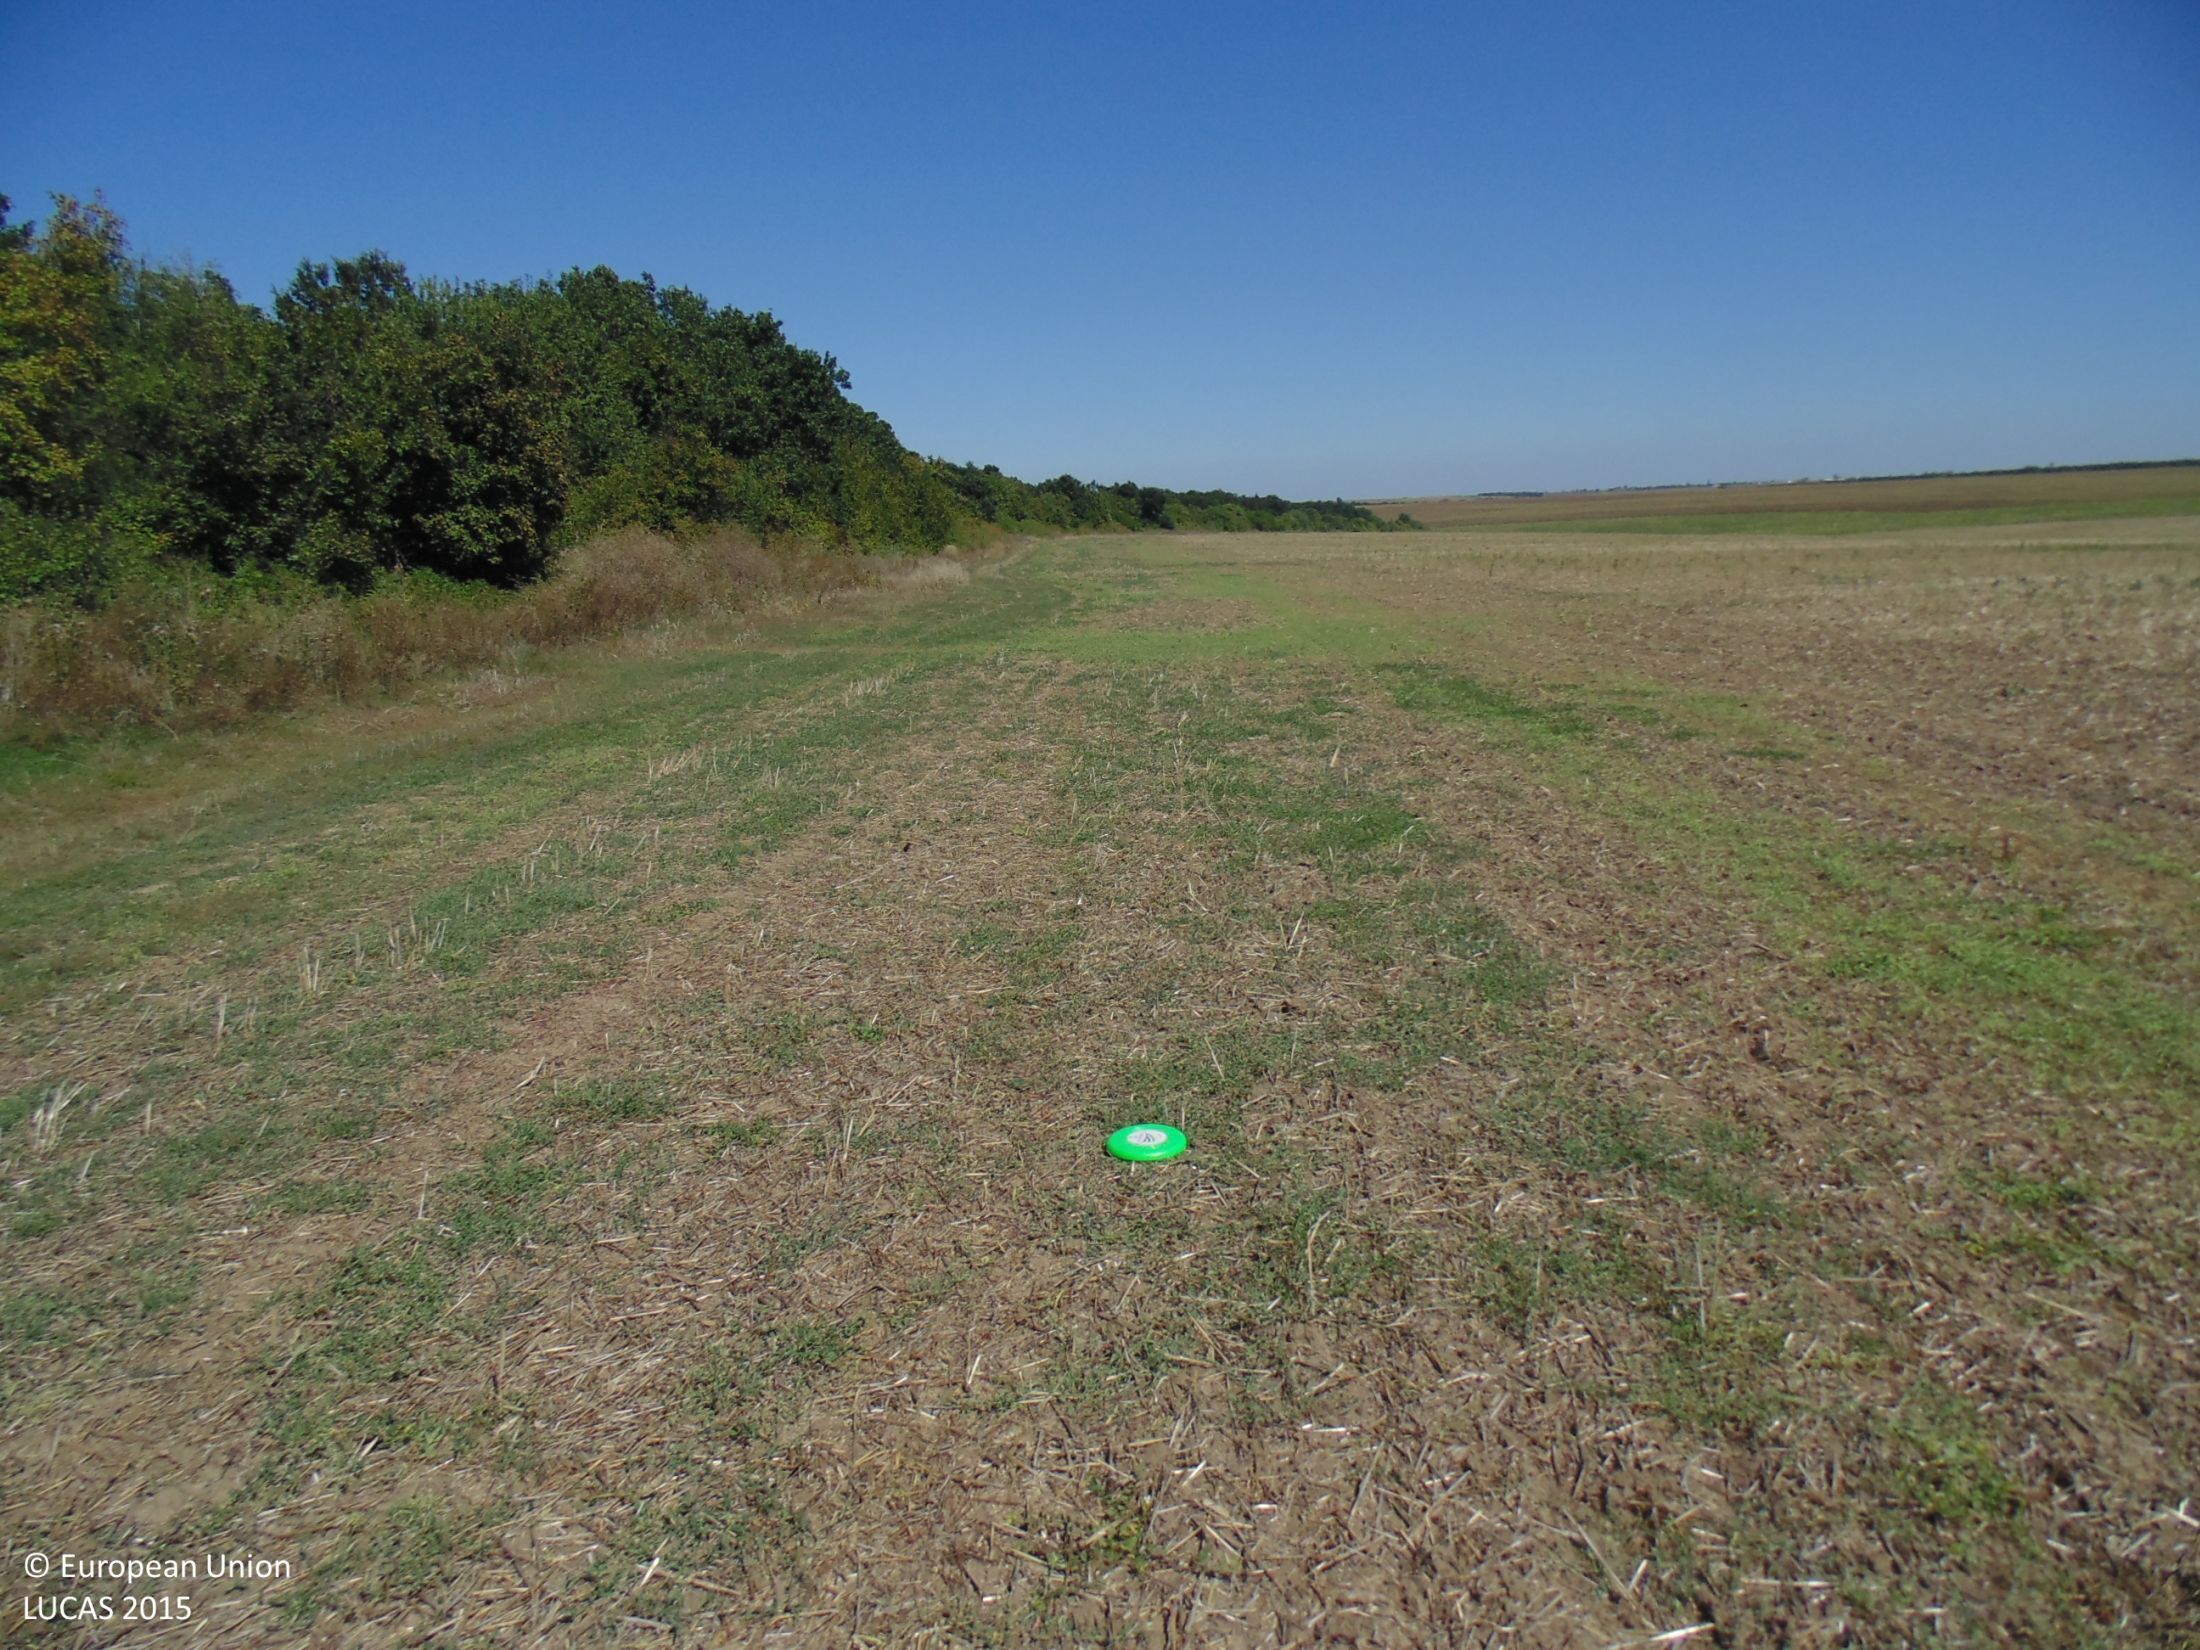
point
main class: Cropland
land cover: Common wheat
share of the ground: < 10 %
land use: Agriculture (excluding fallow land and kitchen gardens)
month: September
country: BG
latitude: 43.7333
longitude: 27.0691
